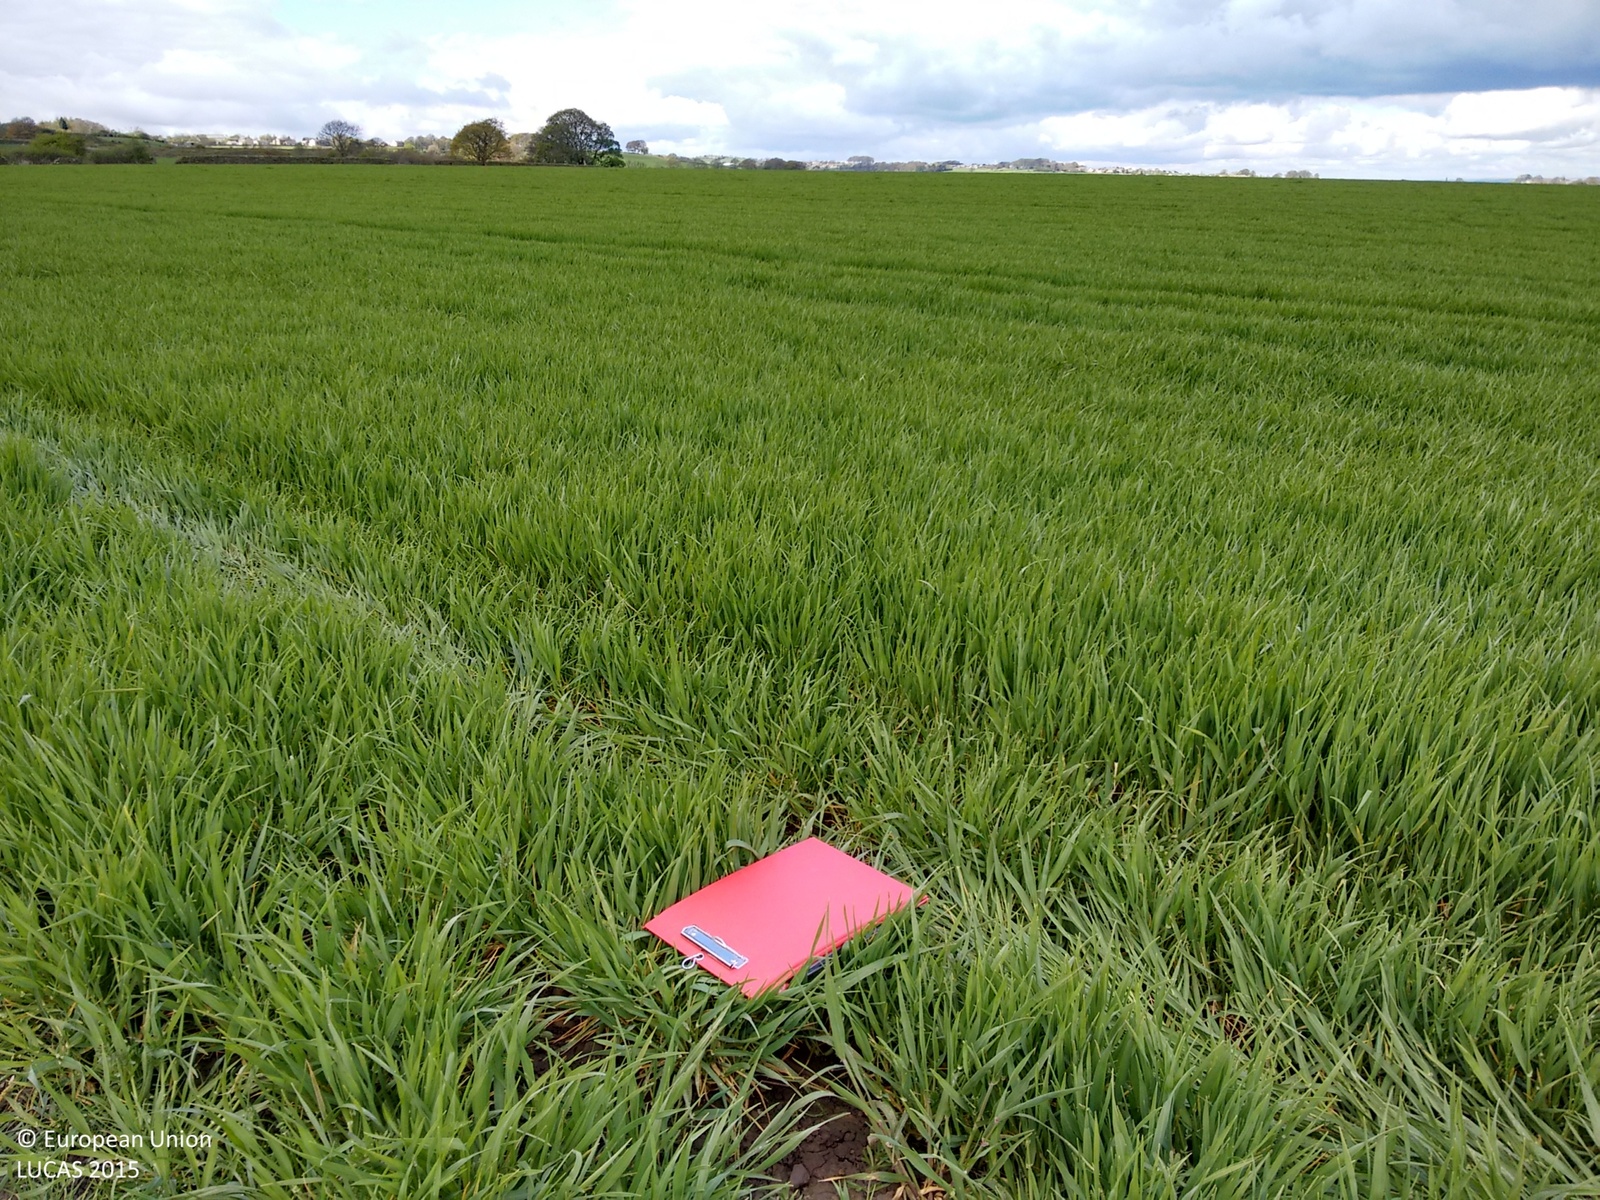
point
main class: Cropland
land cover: Barley
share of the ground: > 75 %
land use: Agriculture (excluding fallow land and kitchen gardens)
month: April
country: GB
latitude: 53.5631
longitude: -1.6626
